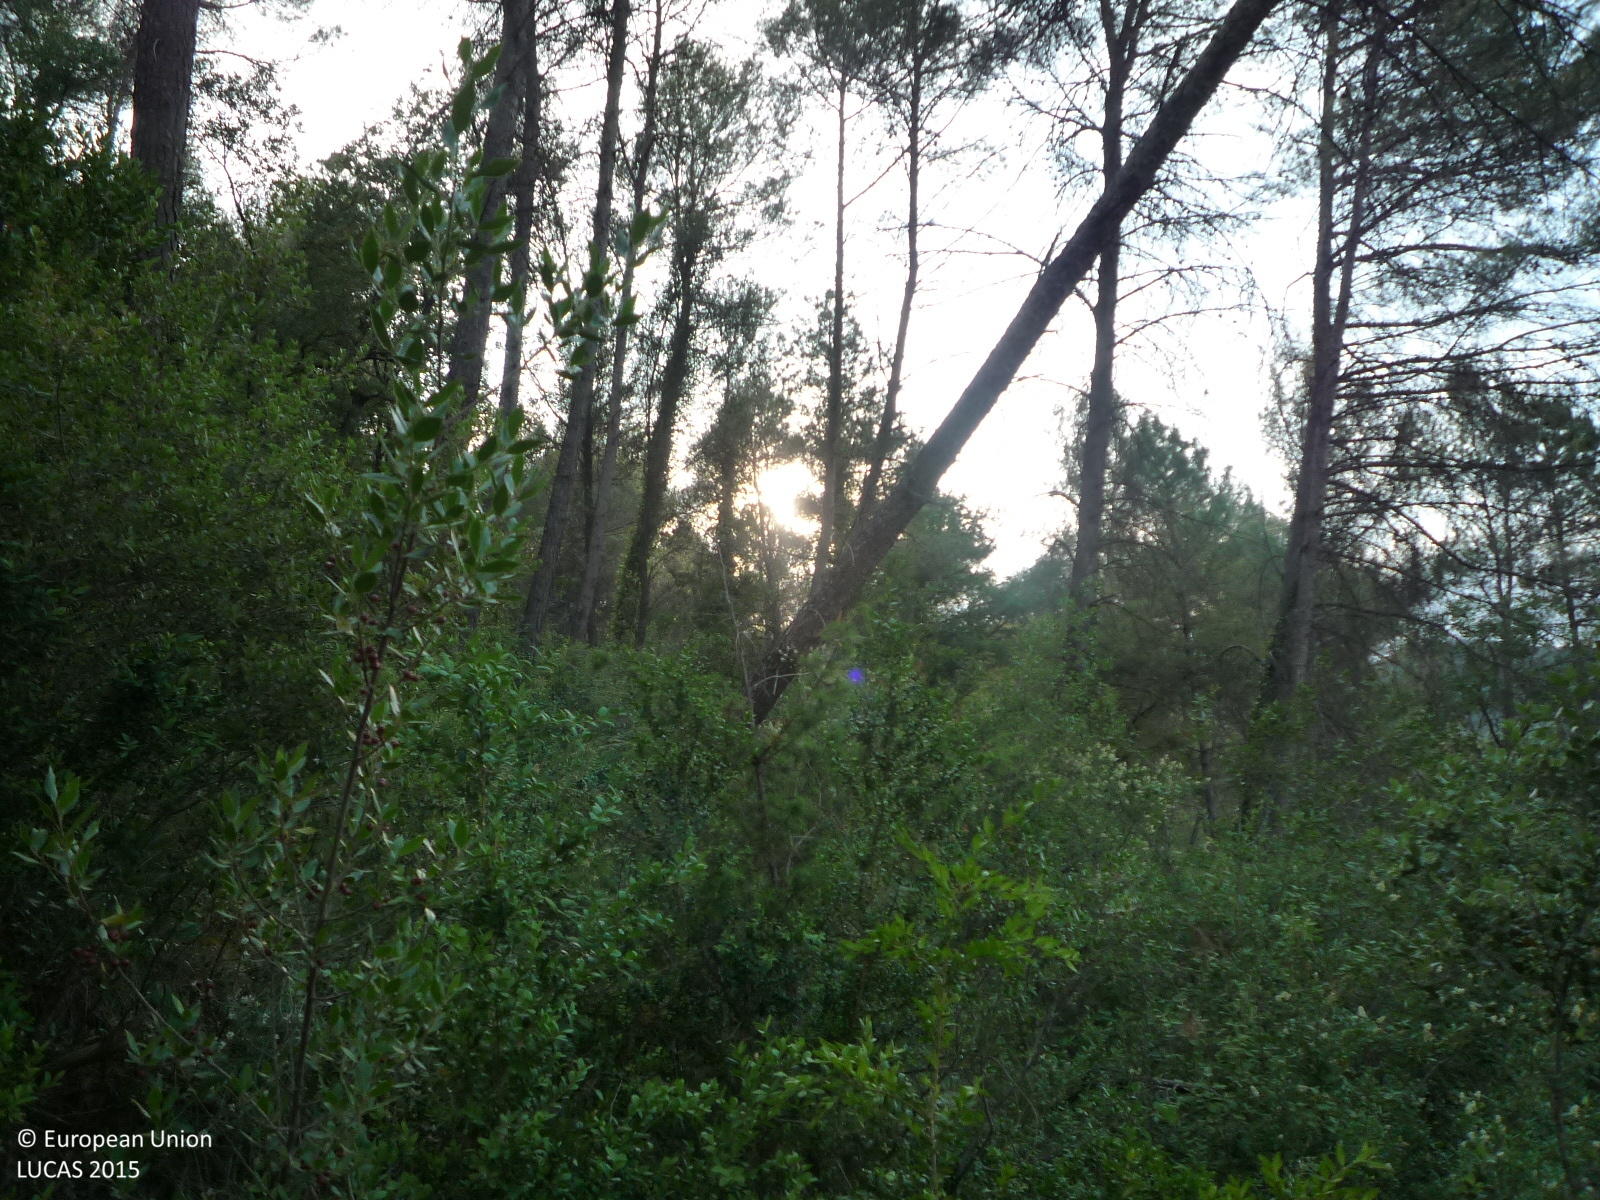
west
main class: Woodland
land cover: Pine dominated mixed woodland
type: coniferous forest of the mediterranean region
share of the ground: > 75 %
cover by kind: coniferous forest trees 60 %, broadleaved forest trees 20 %, herbaceous plants 20 %
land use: Forestry
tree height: > 5 m
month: May
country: ES
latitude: 41.8439
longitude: 1.9577
